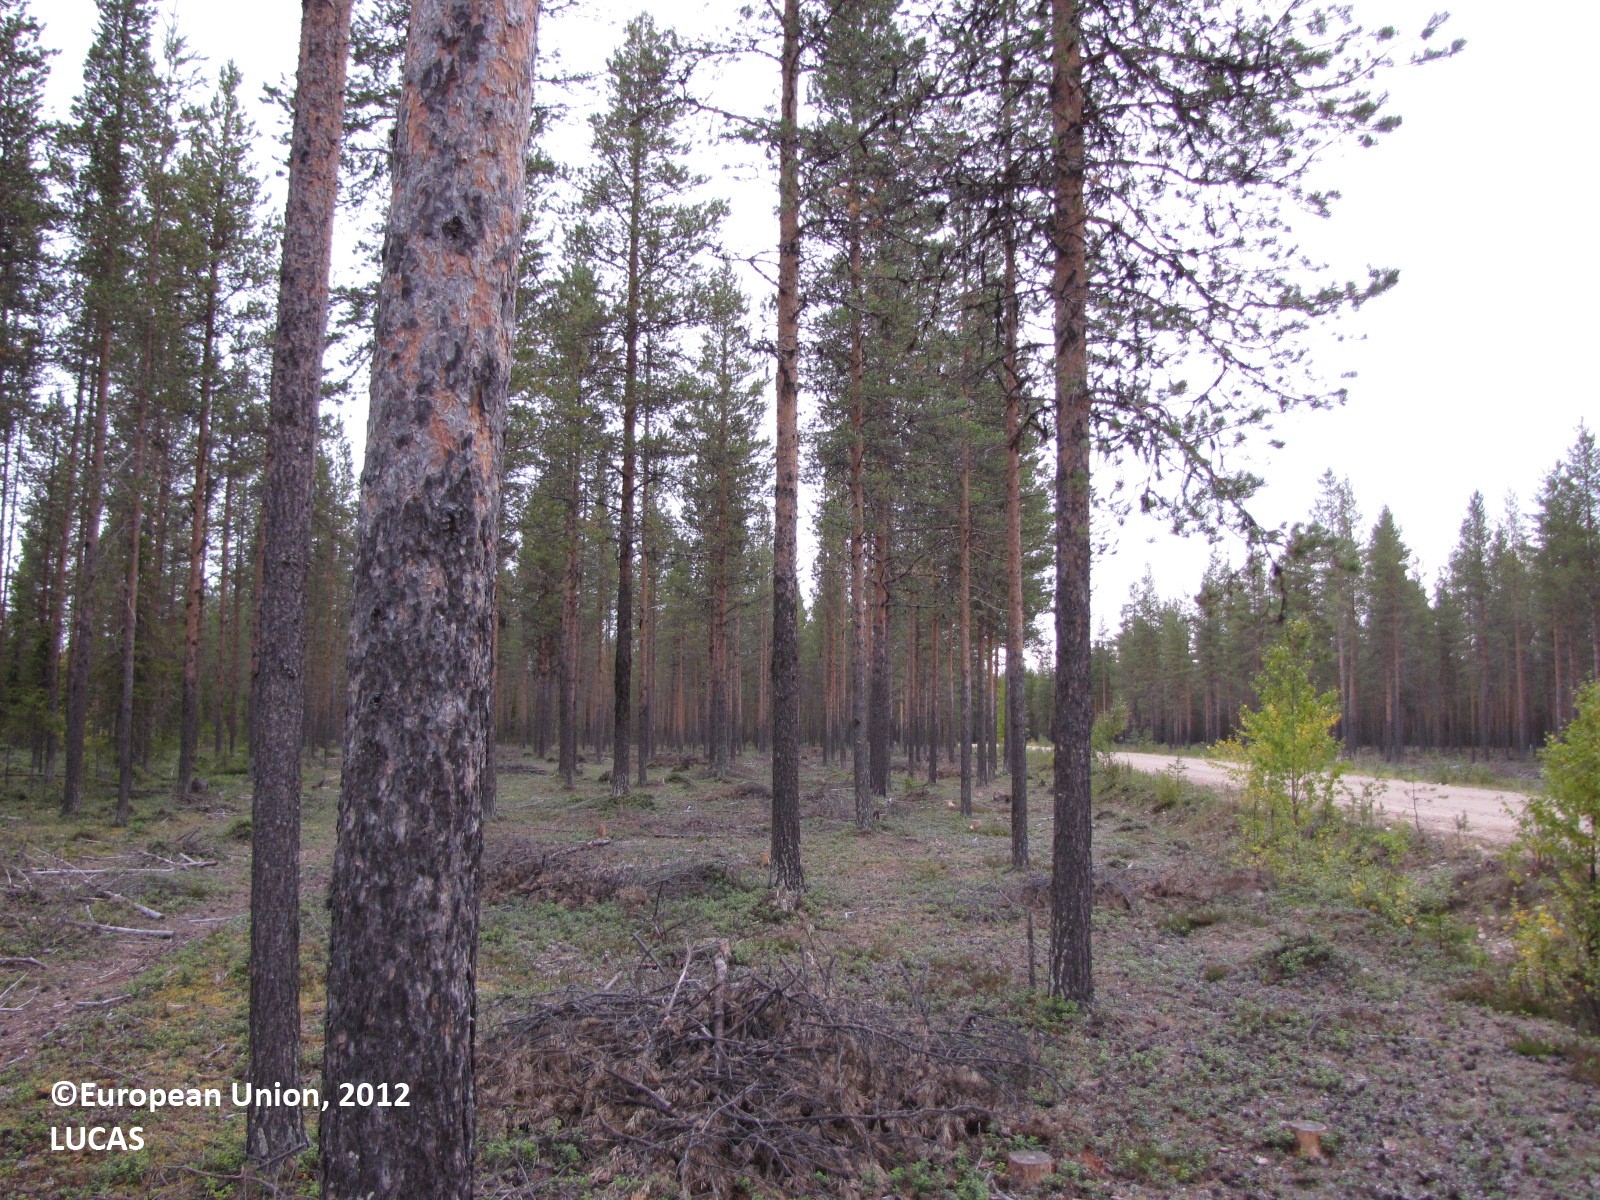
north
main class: Woodland
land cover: Pine dominated coniferous woodland
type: boreal forest
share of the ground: 50 - 75 %
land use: Forestry
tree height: > 5 m
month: September
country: FI
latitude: 67.2083
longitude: 24.8223
